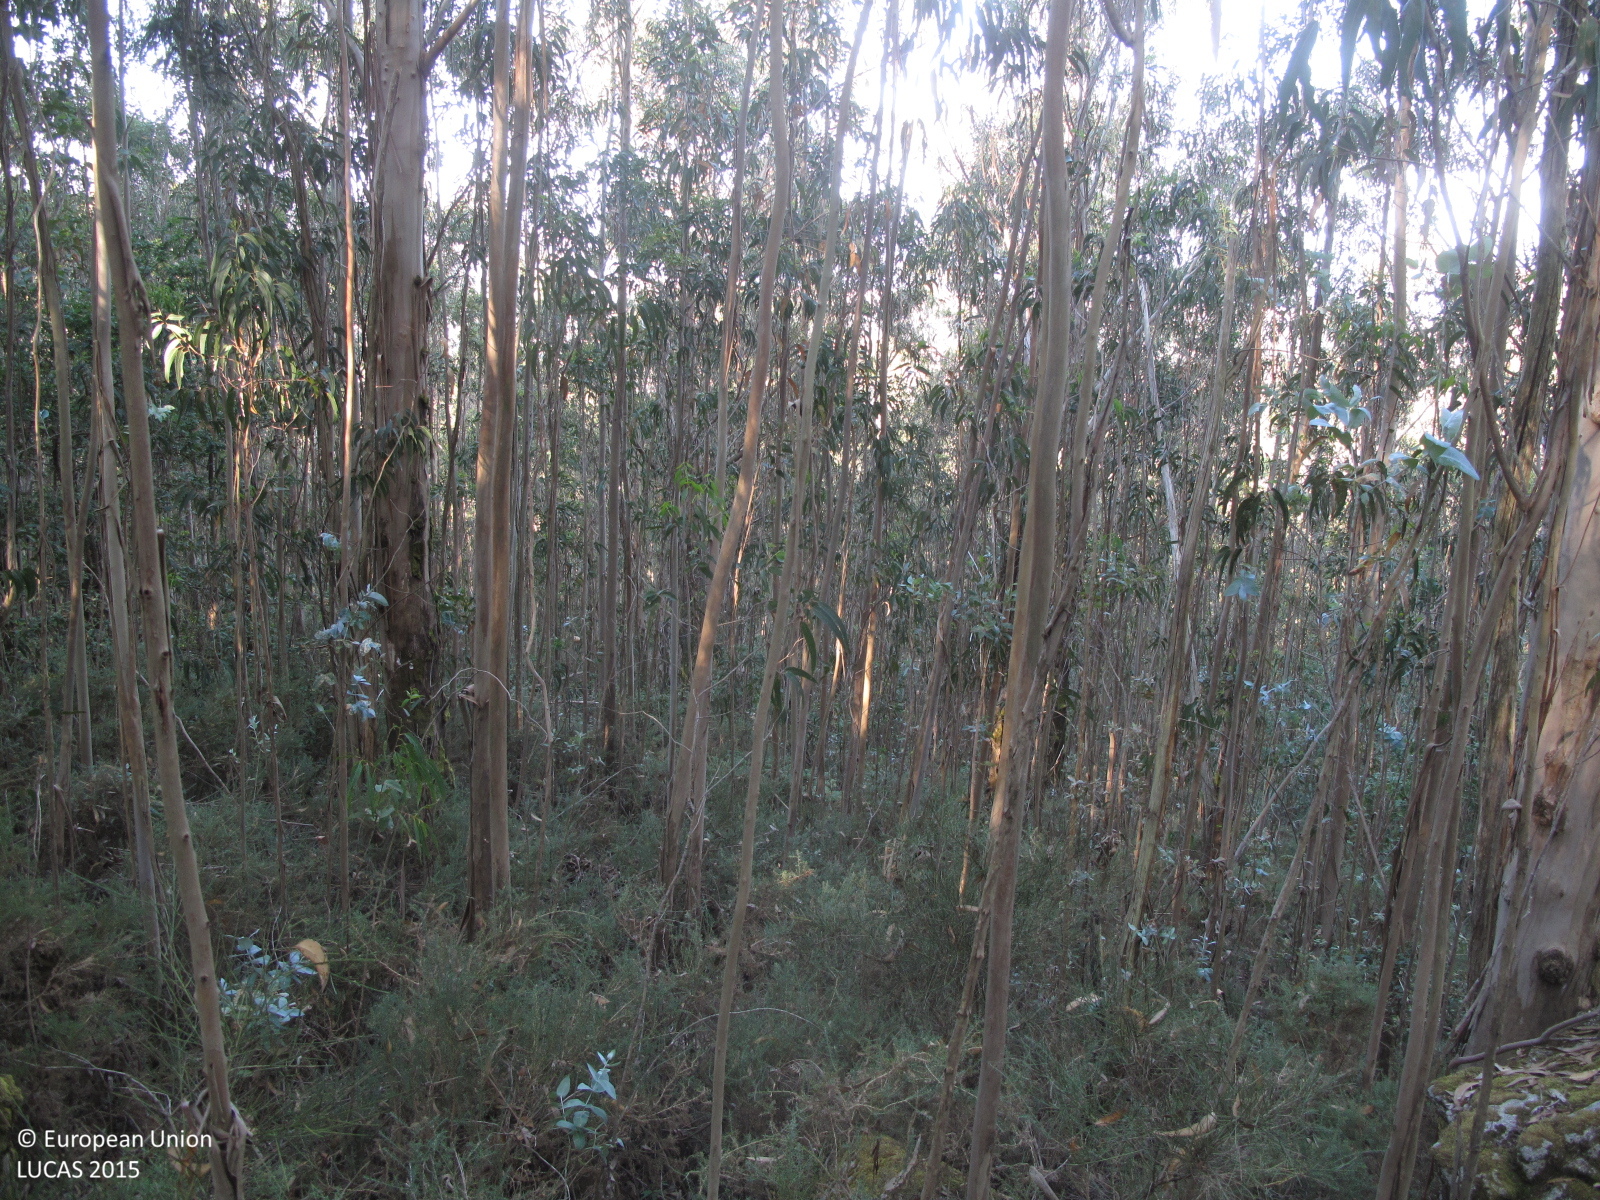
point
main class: Woodland
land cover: Broadleaved woodland
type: exotic forest
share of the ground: > 75 %
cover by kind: broadleaved forest trees 80 %, shrubs 20 %
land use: Forestry
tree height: > 5 m
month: July
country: ES
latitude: 42.8385
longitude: -9.0729
